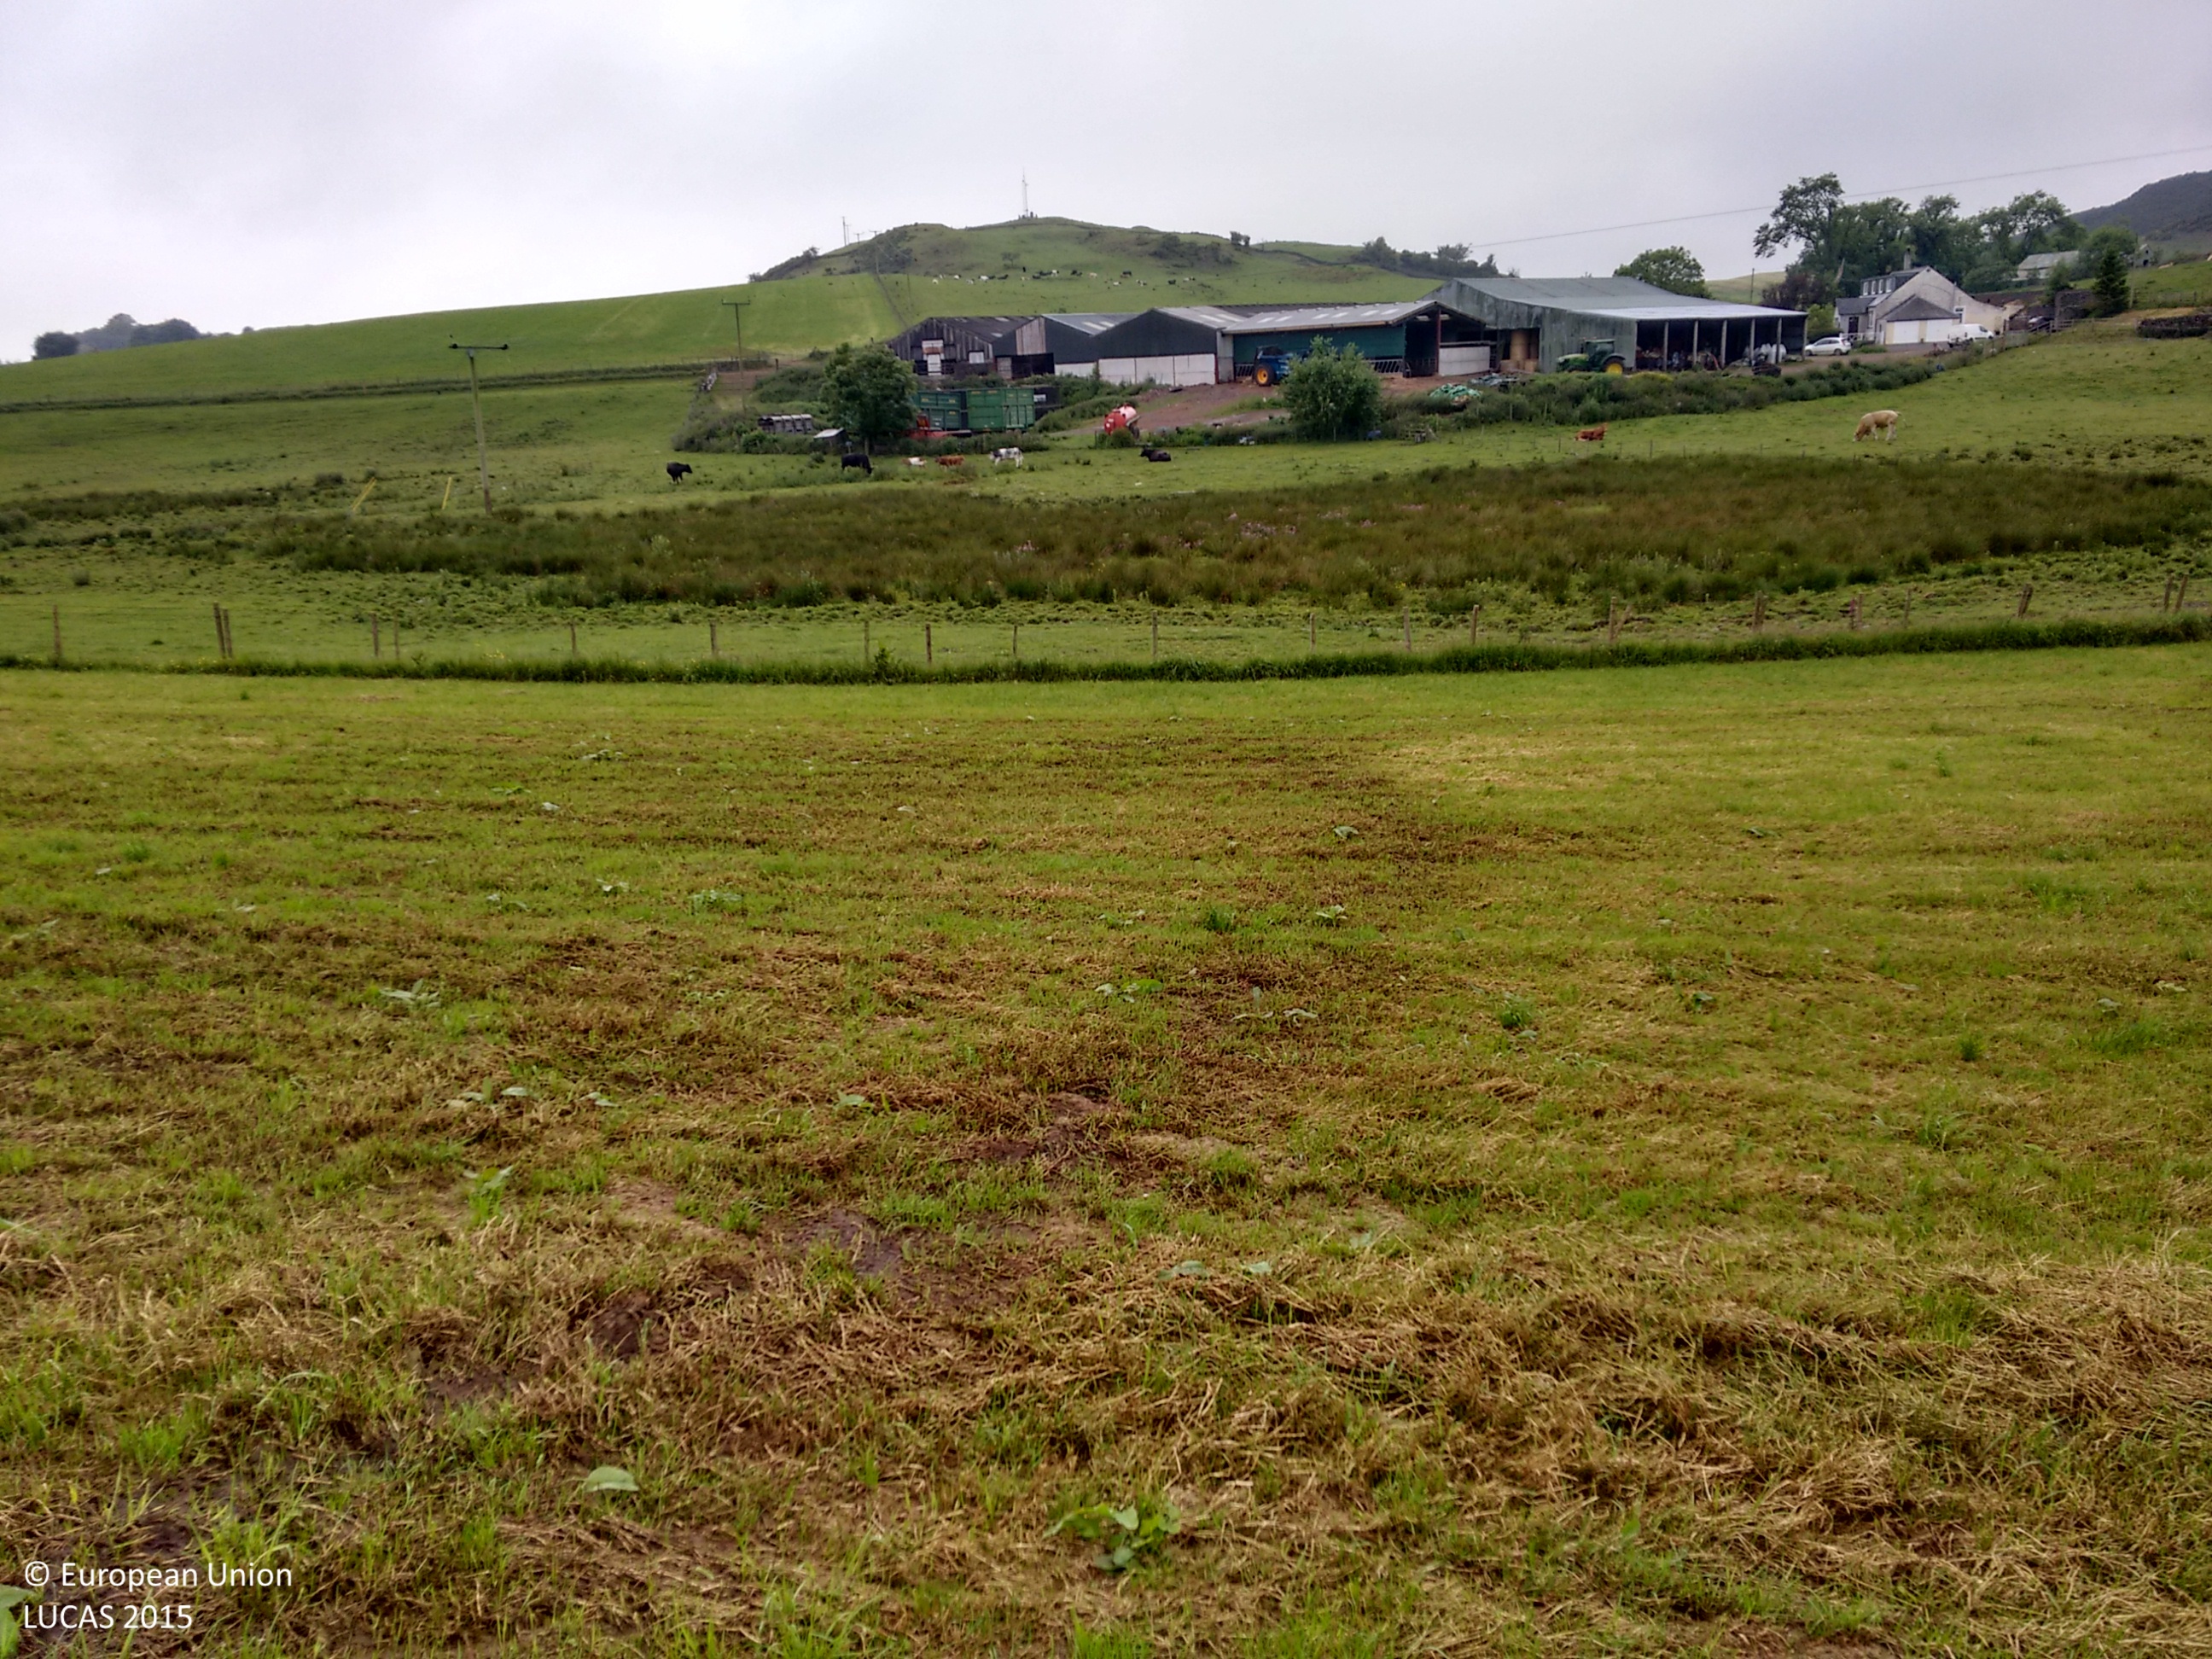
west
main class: Grassland
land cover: Grassland without tree/shrub cover
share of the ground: 25 - 50 %
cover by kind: herbaceous plants 50 %, unconsolidated bare surface 50 %
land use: Agriculture (excluding fallow land and kitchen gardens)
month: June
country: GB
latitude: 55.0656
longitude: -3.6915
